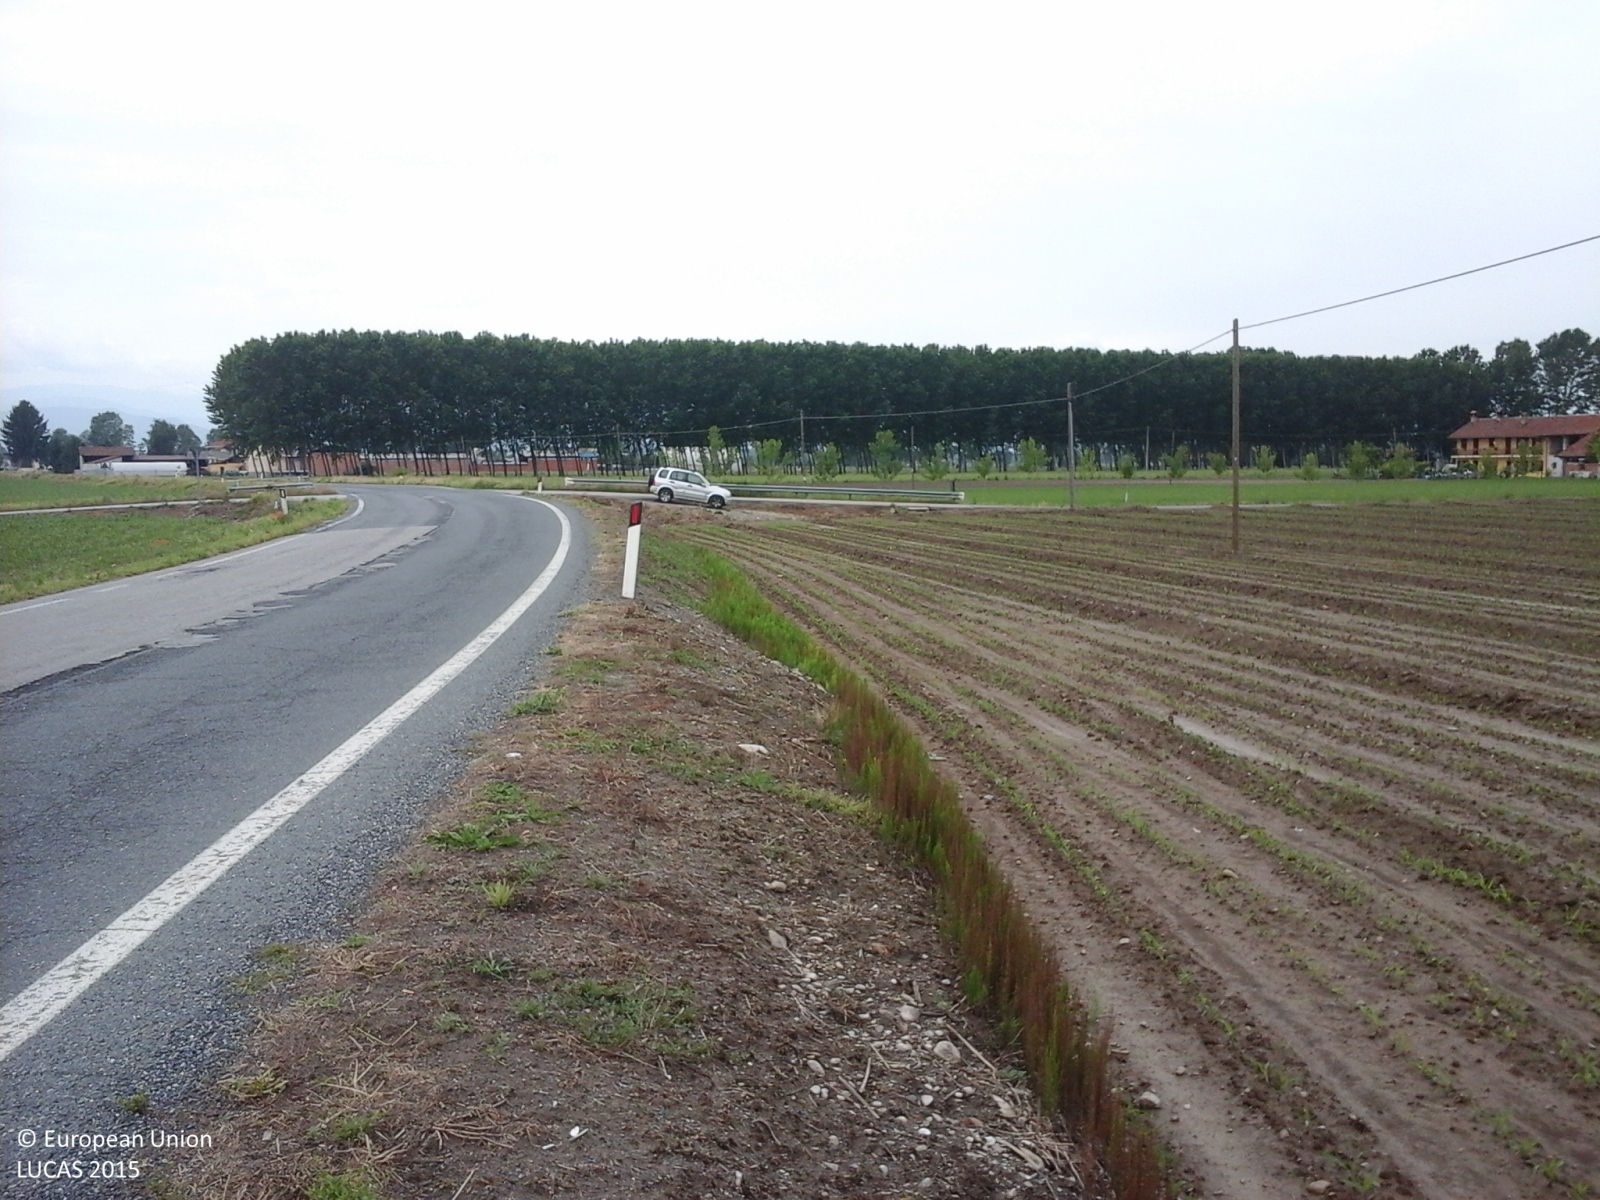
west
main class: Cropland
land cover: Maize
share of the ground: < 10 %
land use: Agriculture (excluding fallow land and kitchen gardens)
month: May
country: IT
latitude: 44.5585
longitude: 7.6505
